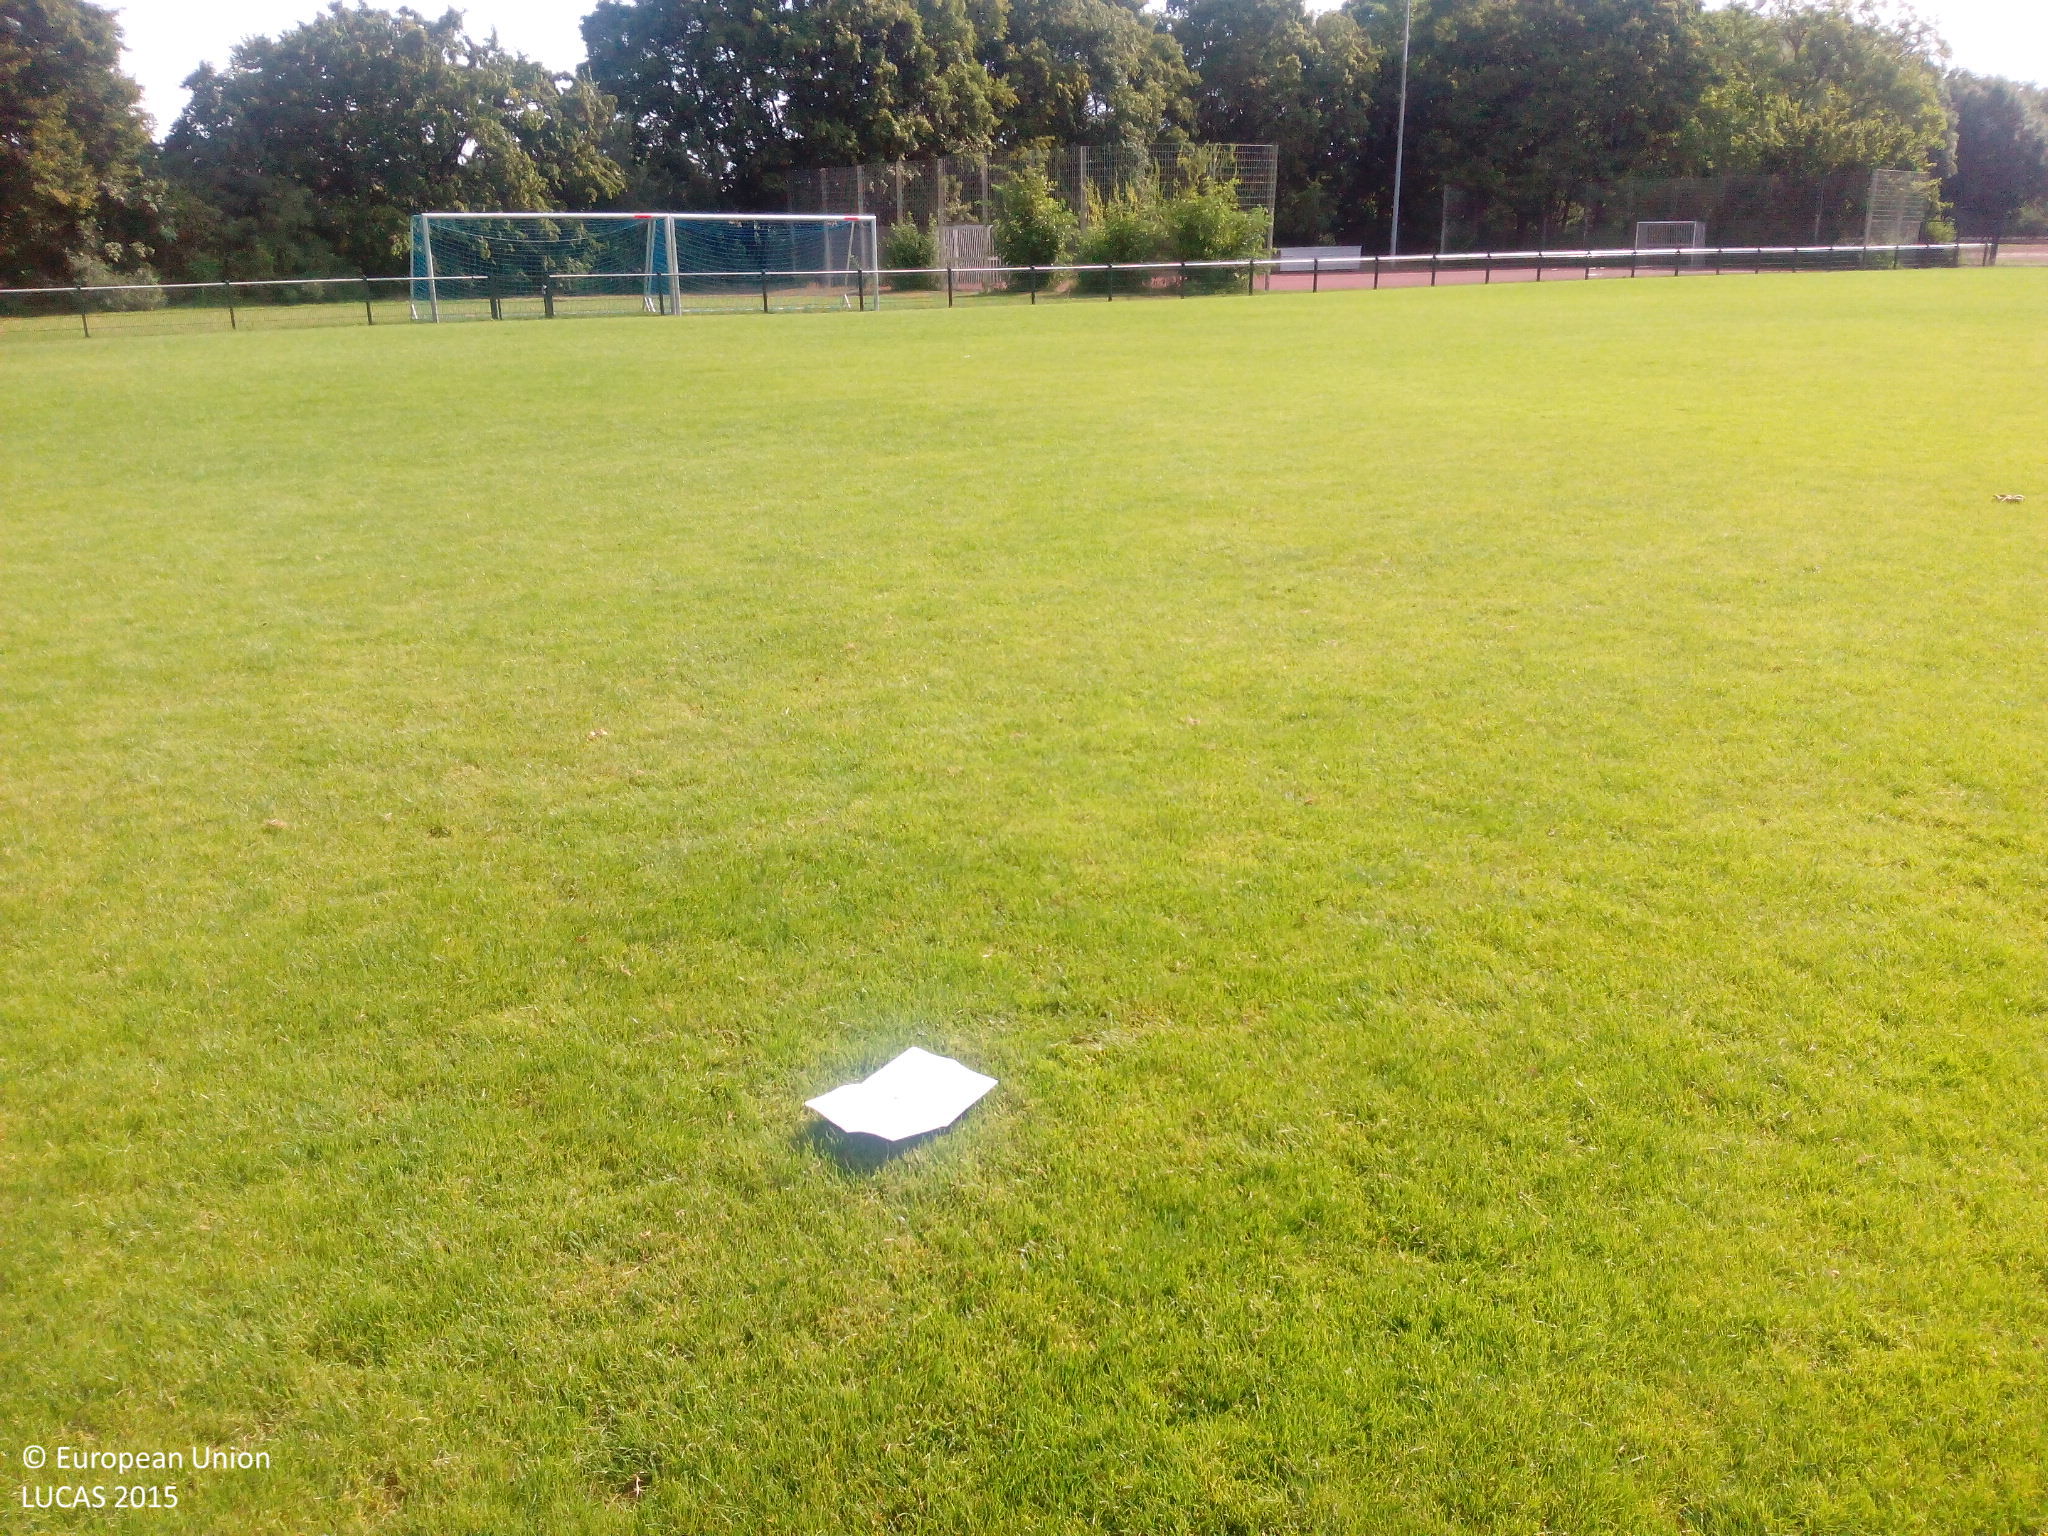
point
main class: Grassland
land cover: Grassland without tree/shrub cover
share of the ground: > 75 %
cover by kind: herbaceous plants 95 %, unconsolidated bare surface 5 %
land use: Sport
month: August
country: DE
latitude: 49.4736
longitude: 8.5514
